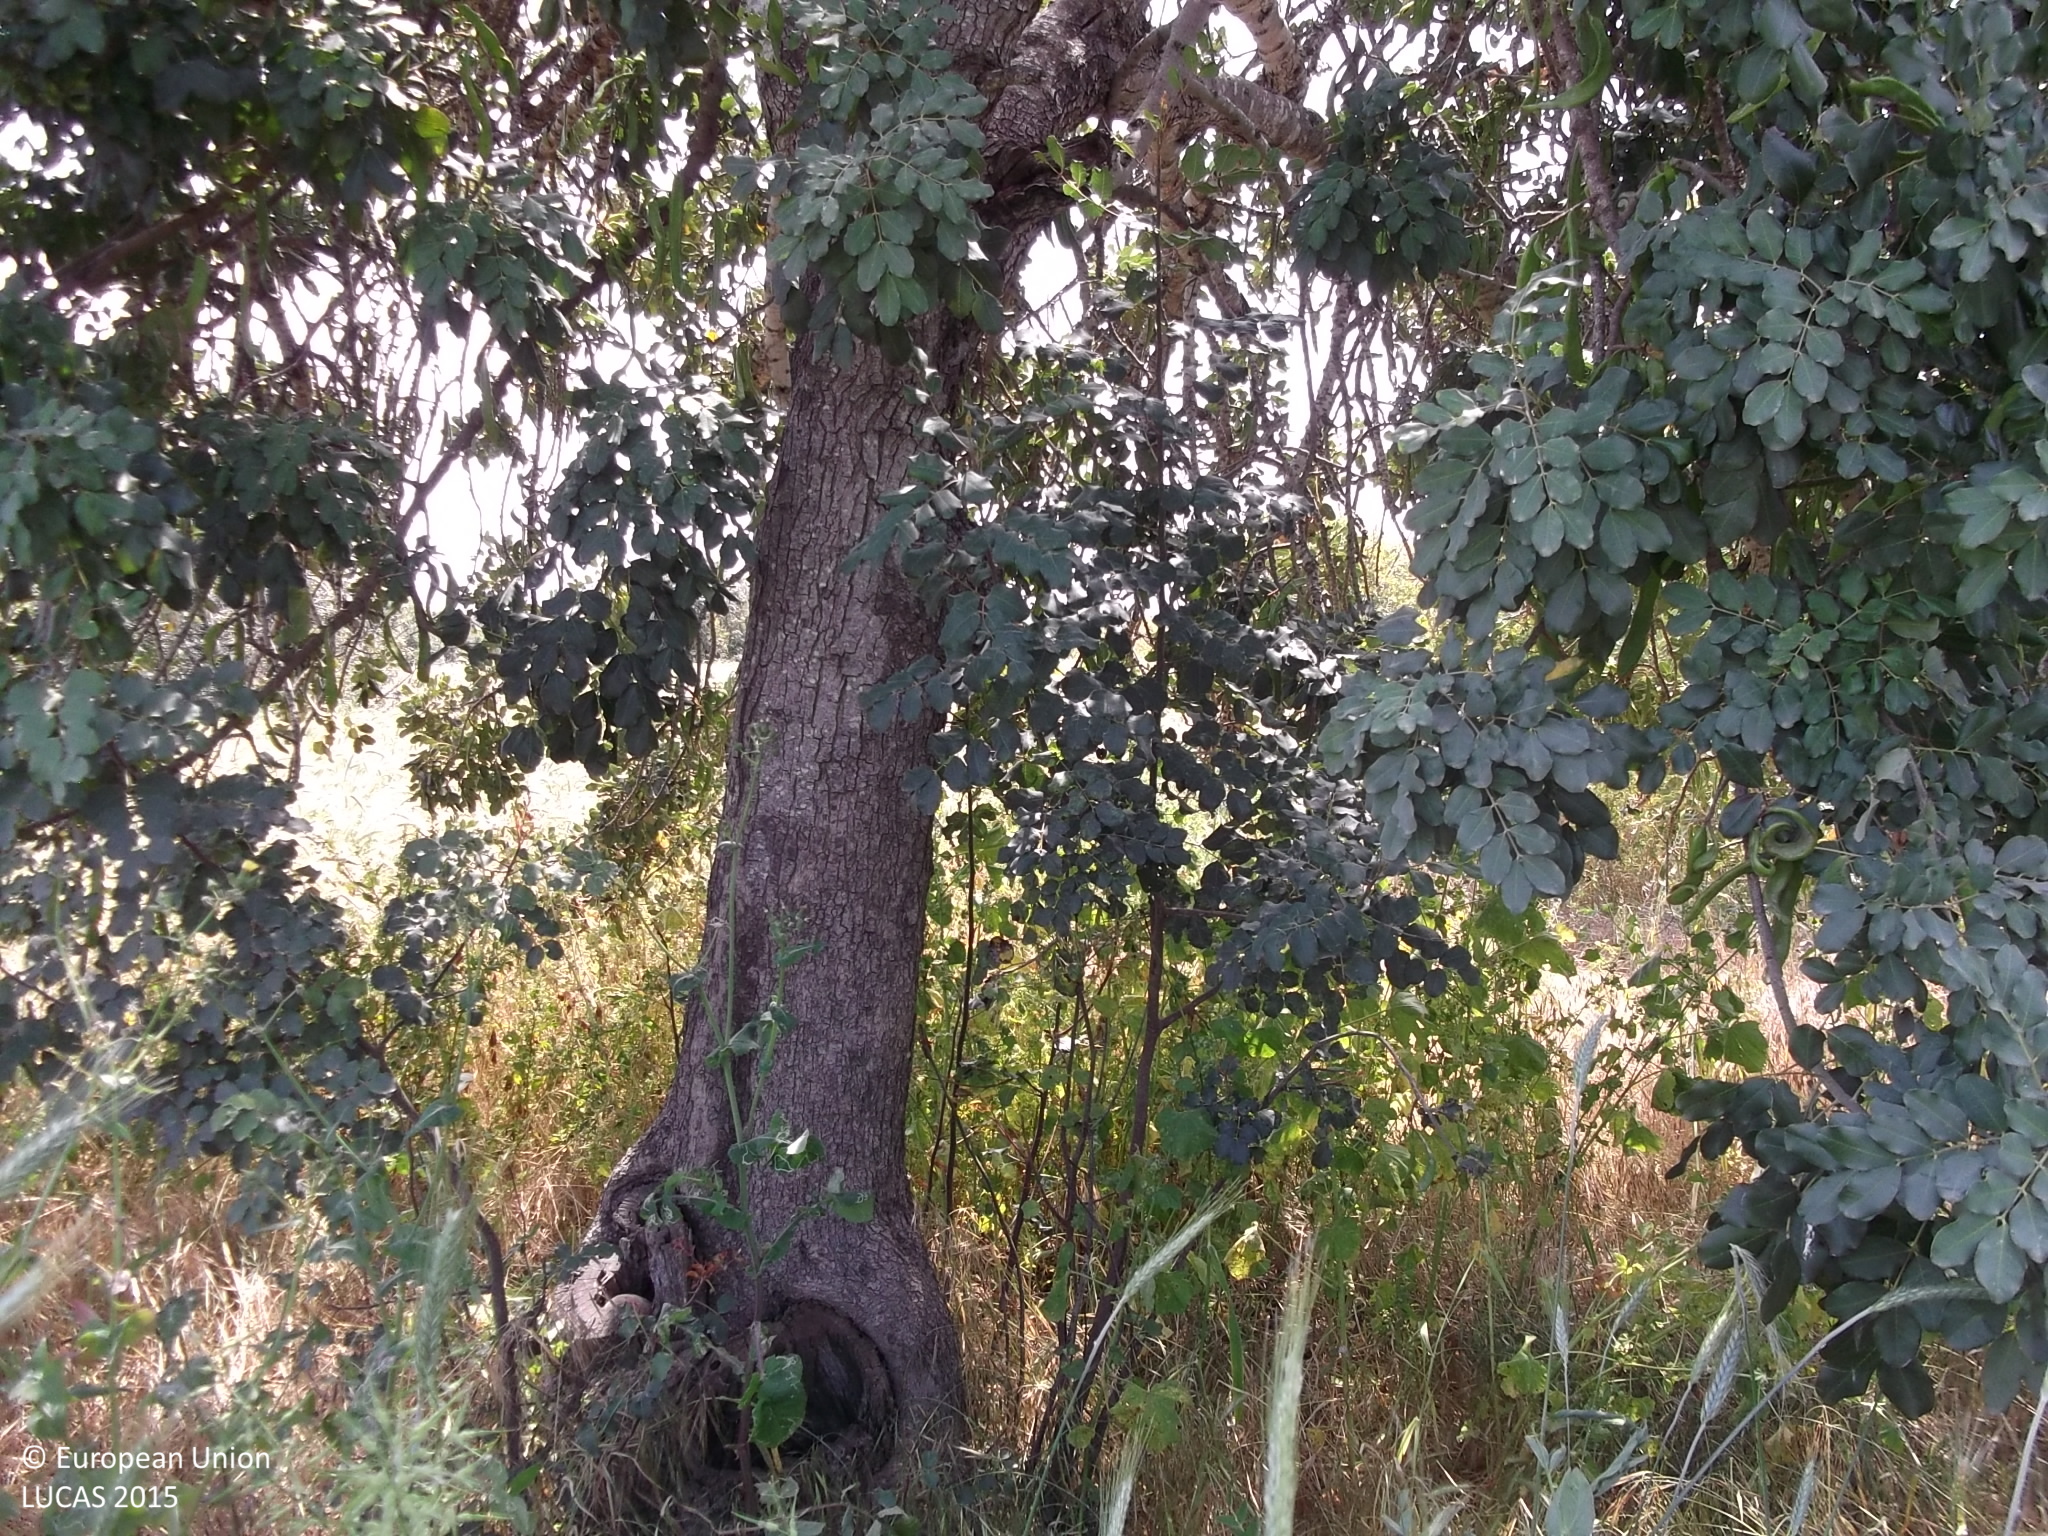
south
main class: Cropland
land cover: Permanent industrial crops
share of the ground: 25 - 50 %
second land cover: Common wheat
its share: > 75 %
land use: Agriculture (excluding fallow land and kitchen gardens)
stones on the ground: 25 - 50 %
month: April
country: CY
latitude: 34.8015
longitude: 33.4790
